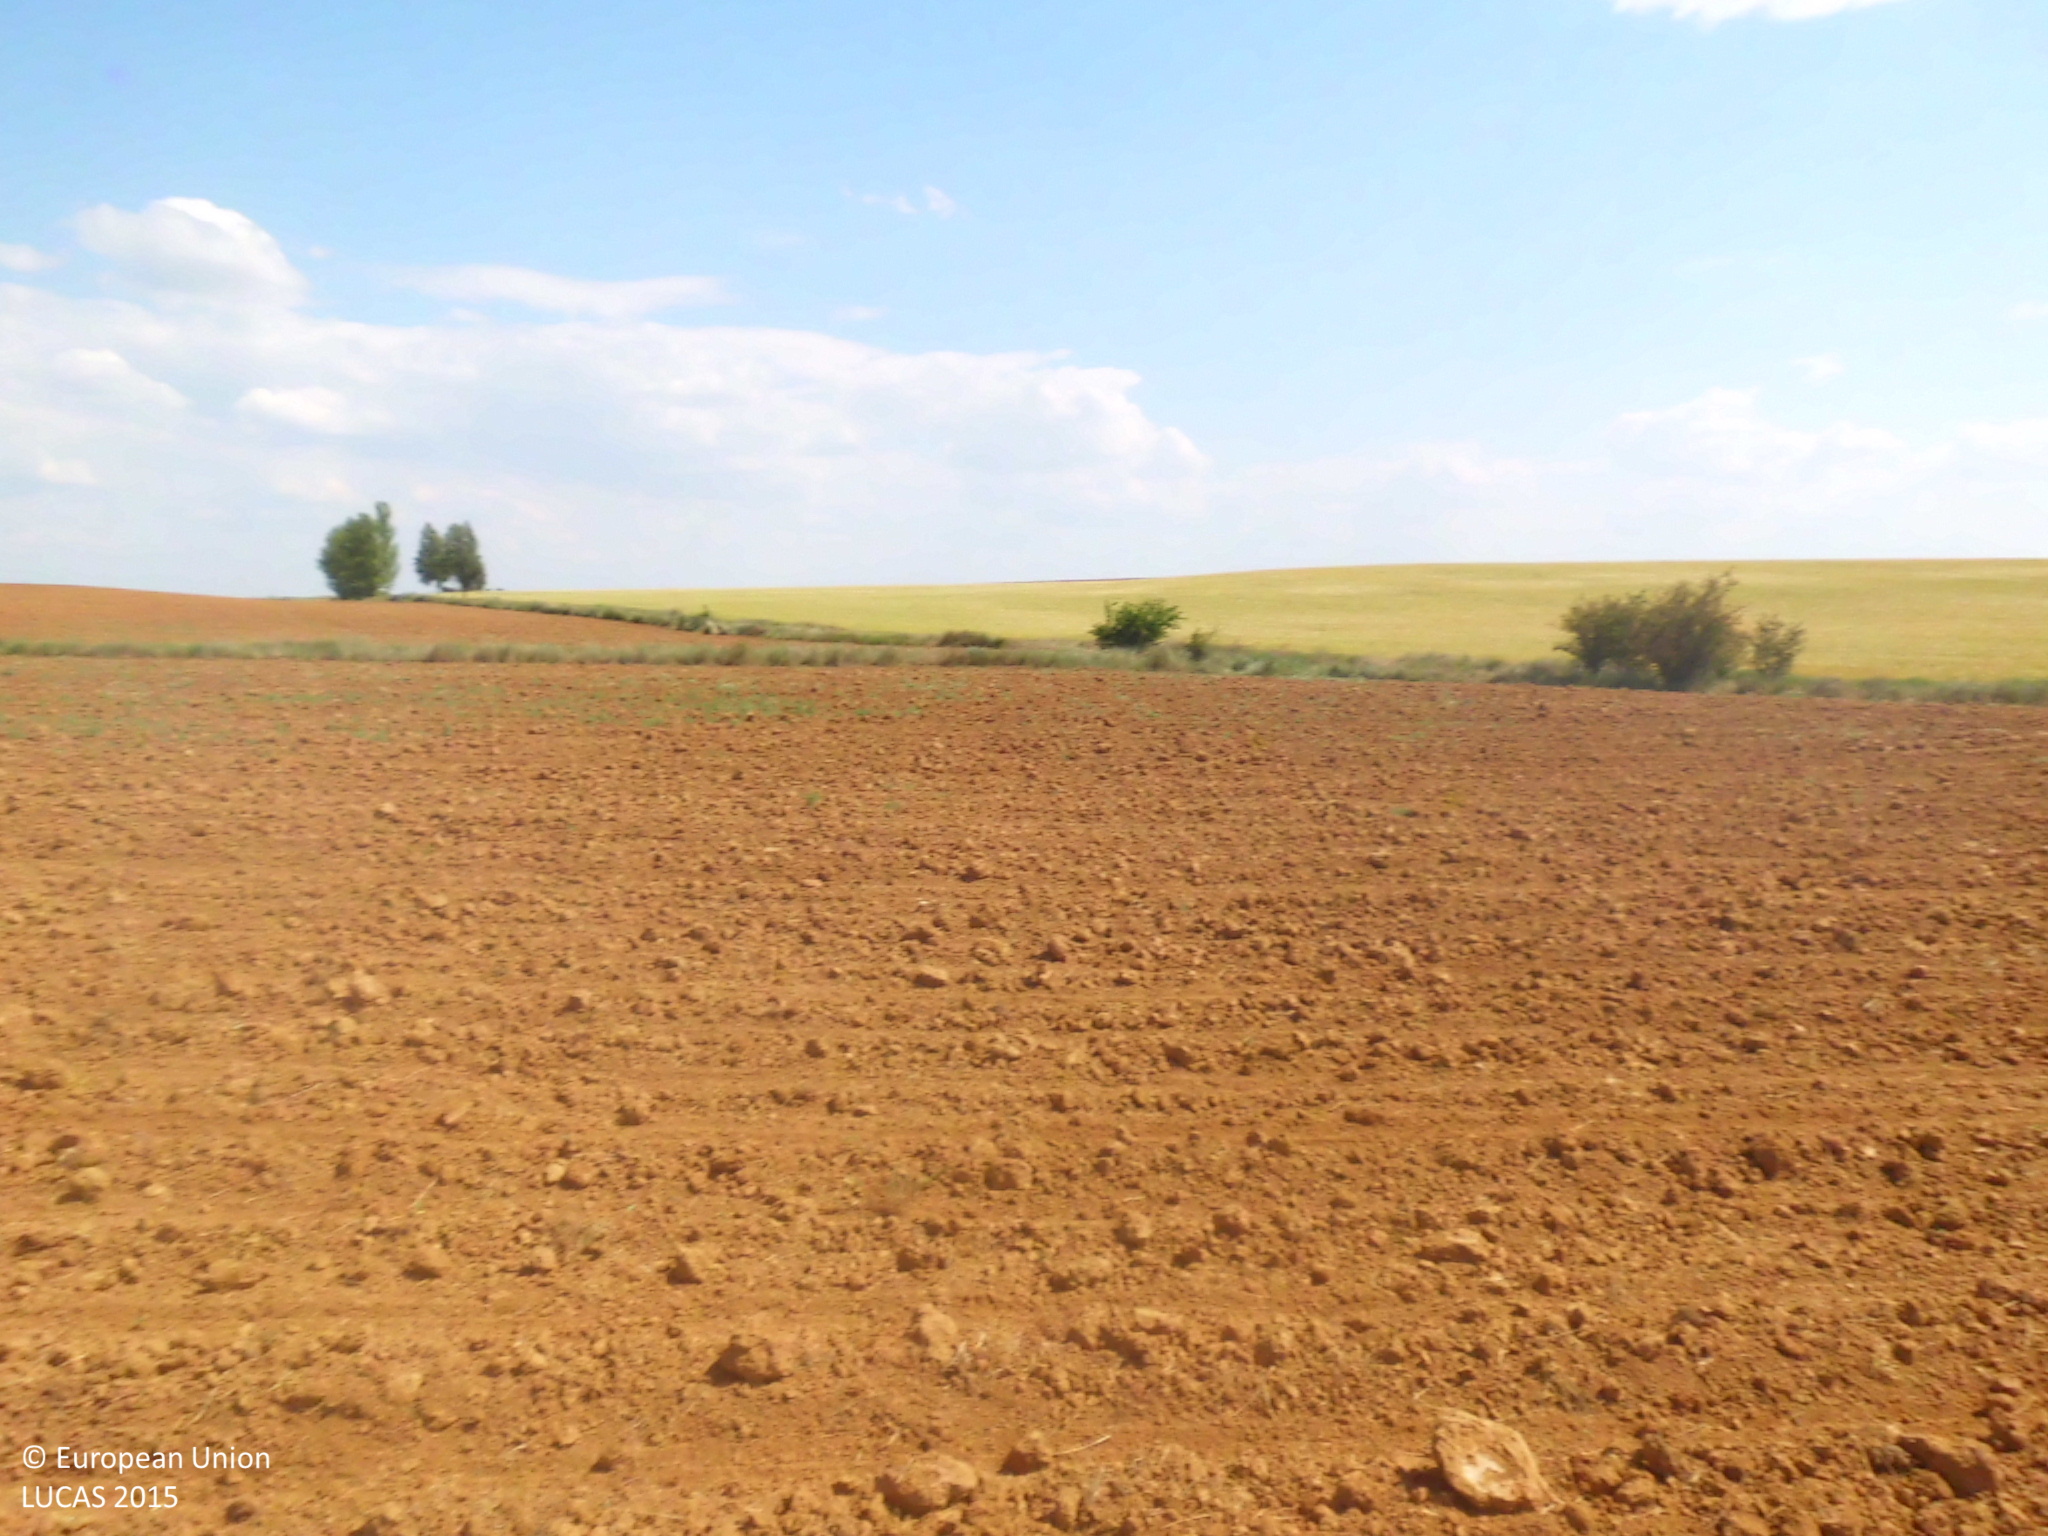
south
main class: Cropland
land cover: Sunflower
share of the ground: < 10 %
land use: Agriculture (excluding fallow land and kitchen gardens)
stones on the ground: < 10 %
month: June
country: ES
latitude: 42.4340
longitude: -4.2068
